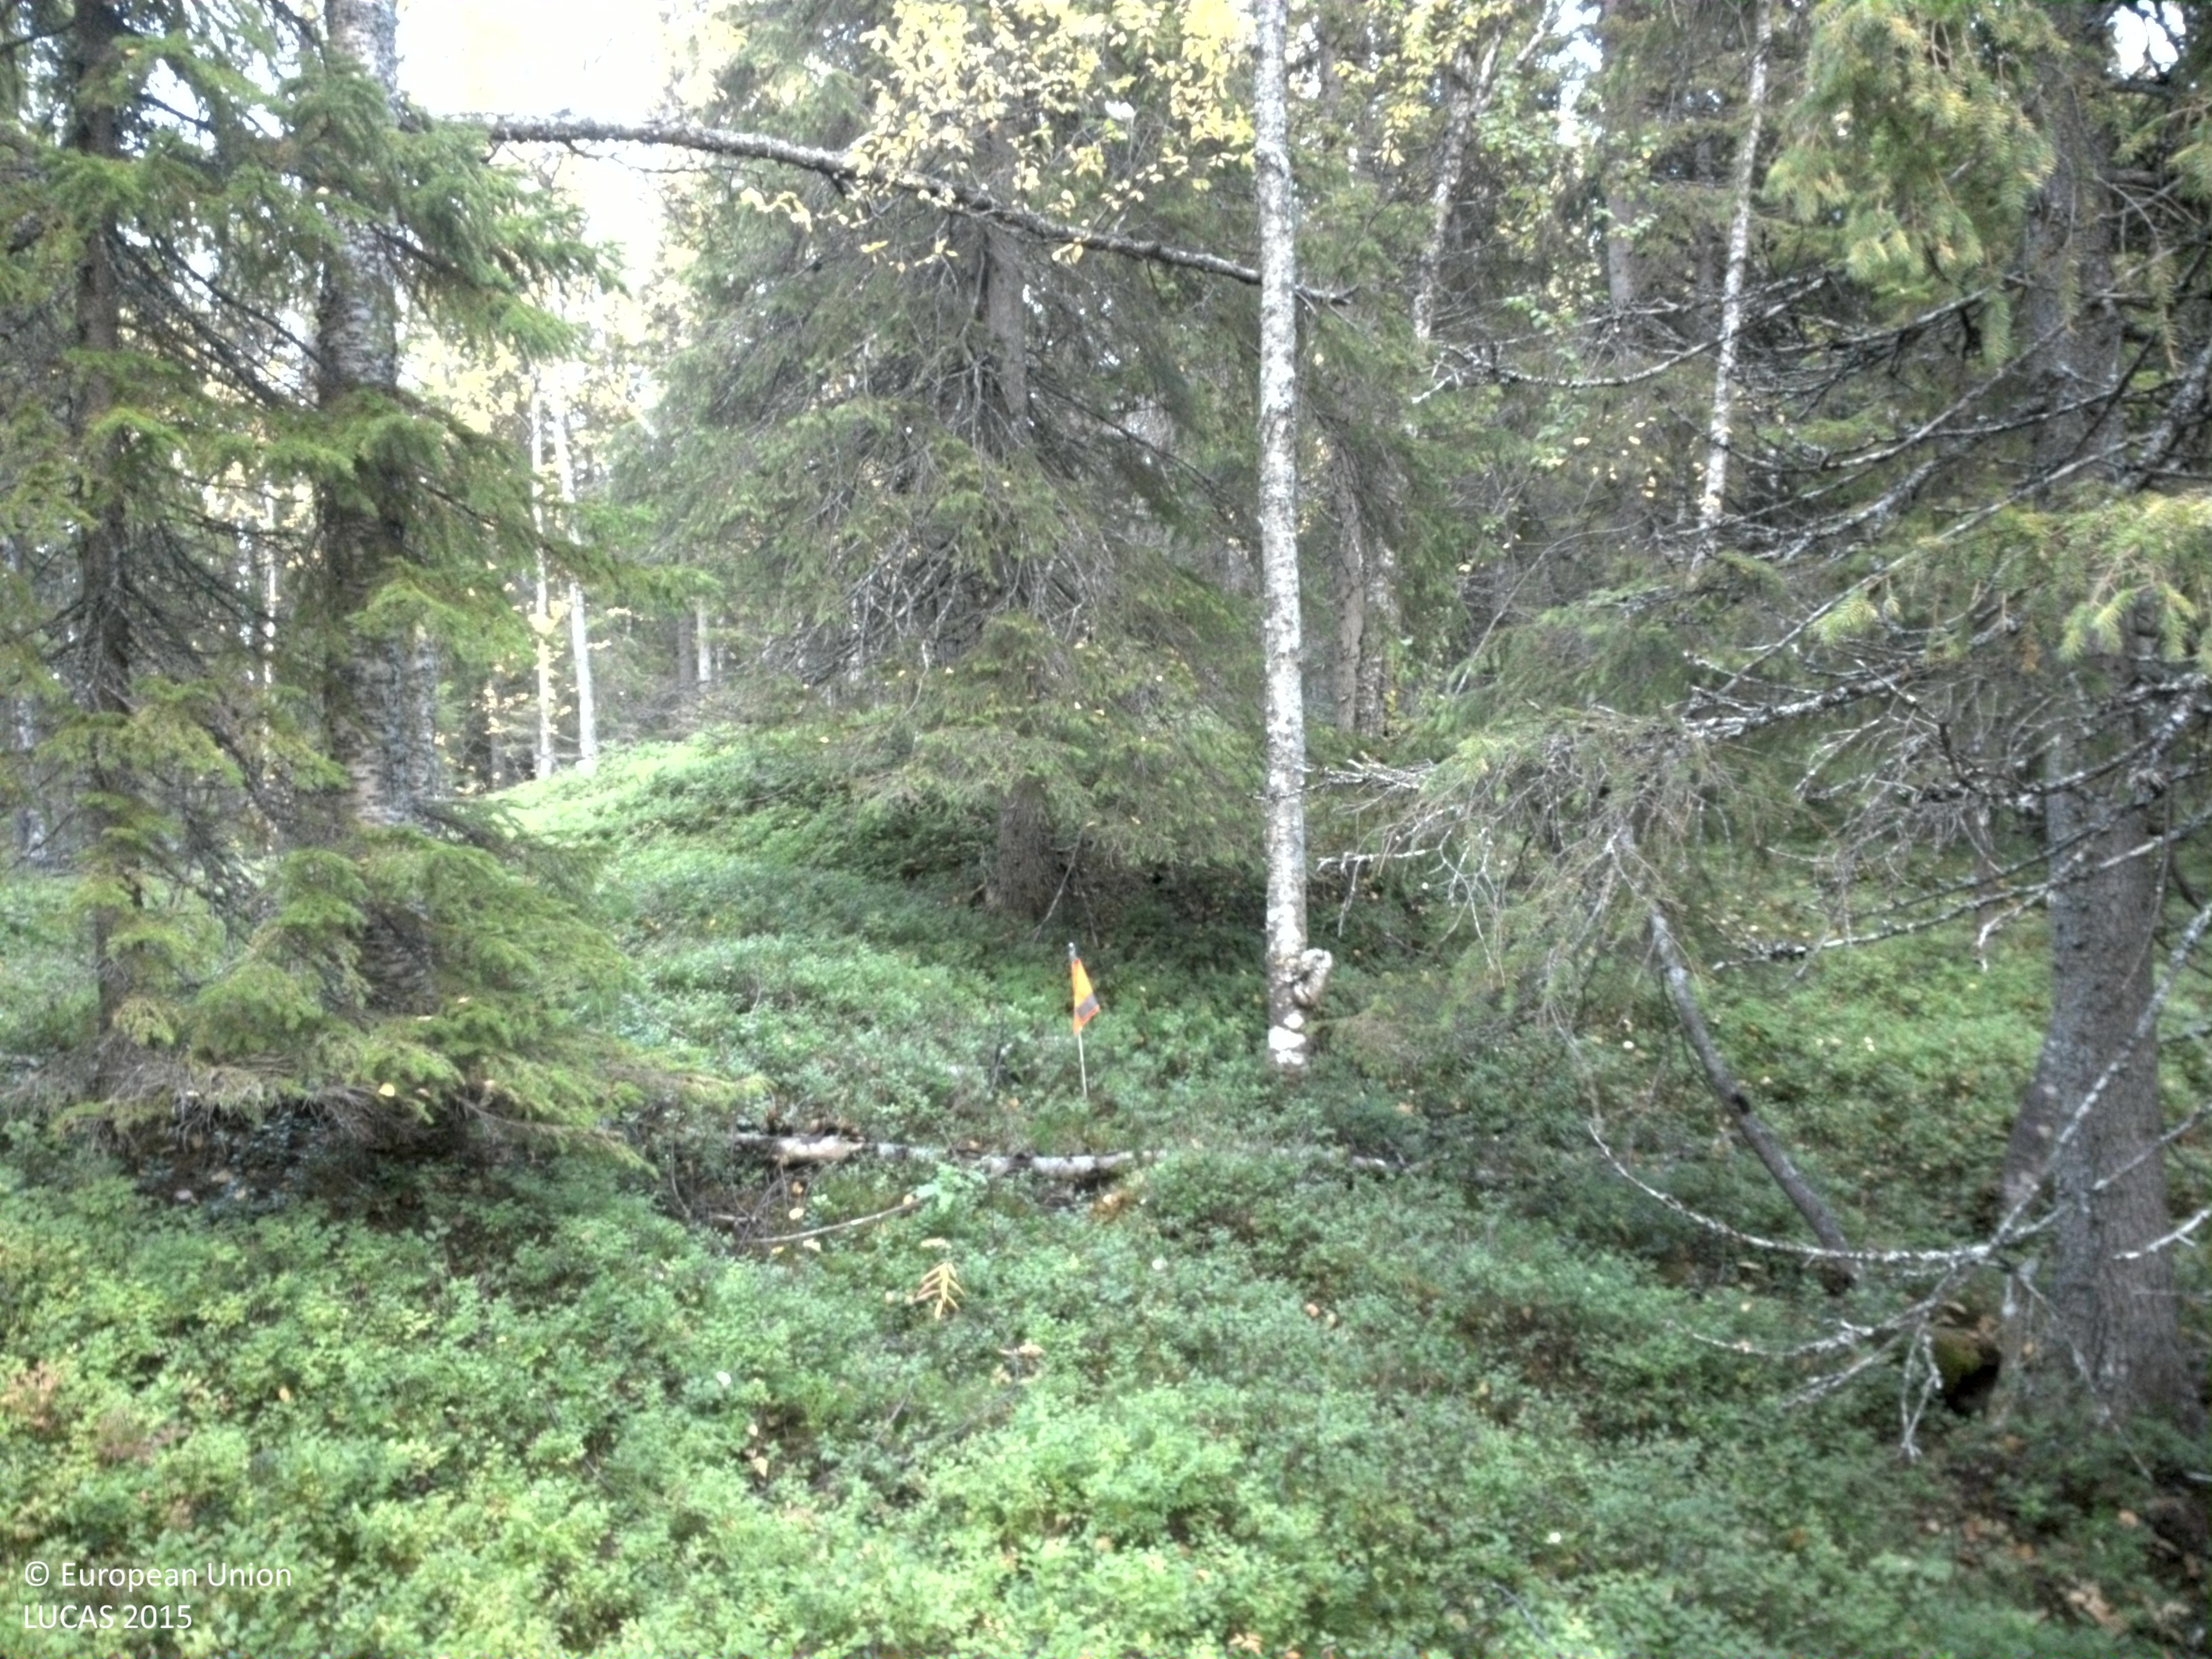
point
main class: Woodland
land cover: Spruce dominated coniferous woodland
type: boreal forest
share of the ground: 25 - 50 %
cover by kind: shrubs 40 %, coniferous forest trees 35 %, lichens and mosses 15 %, broadleaved forest trees 10 %
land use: Forestry
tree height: > 5 m
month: September
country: SE
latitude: 65.3230
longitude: 16.3384
